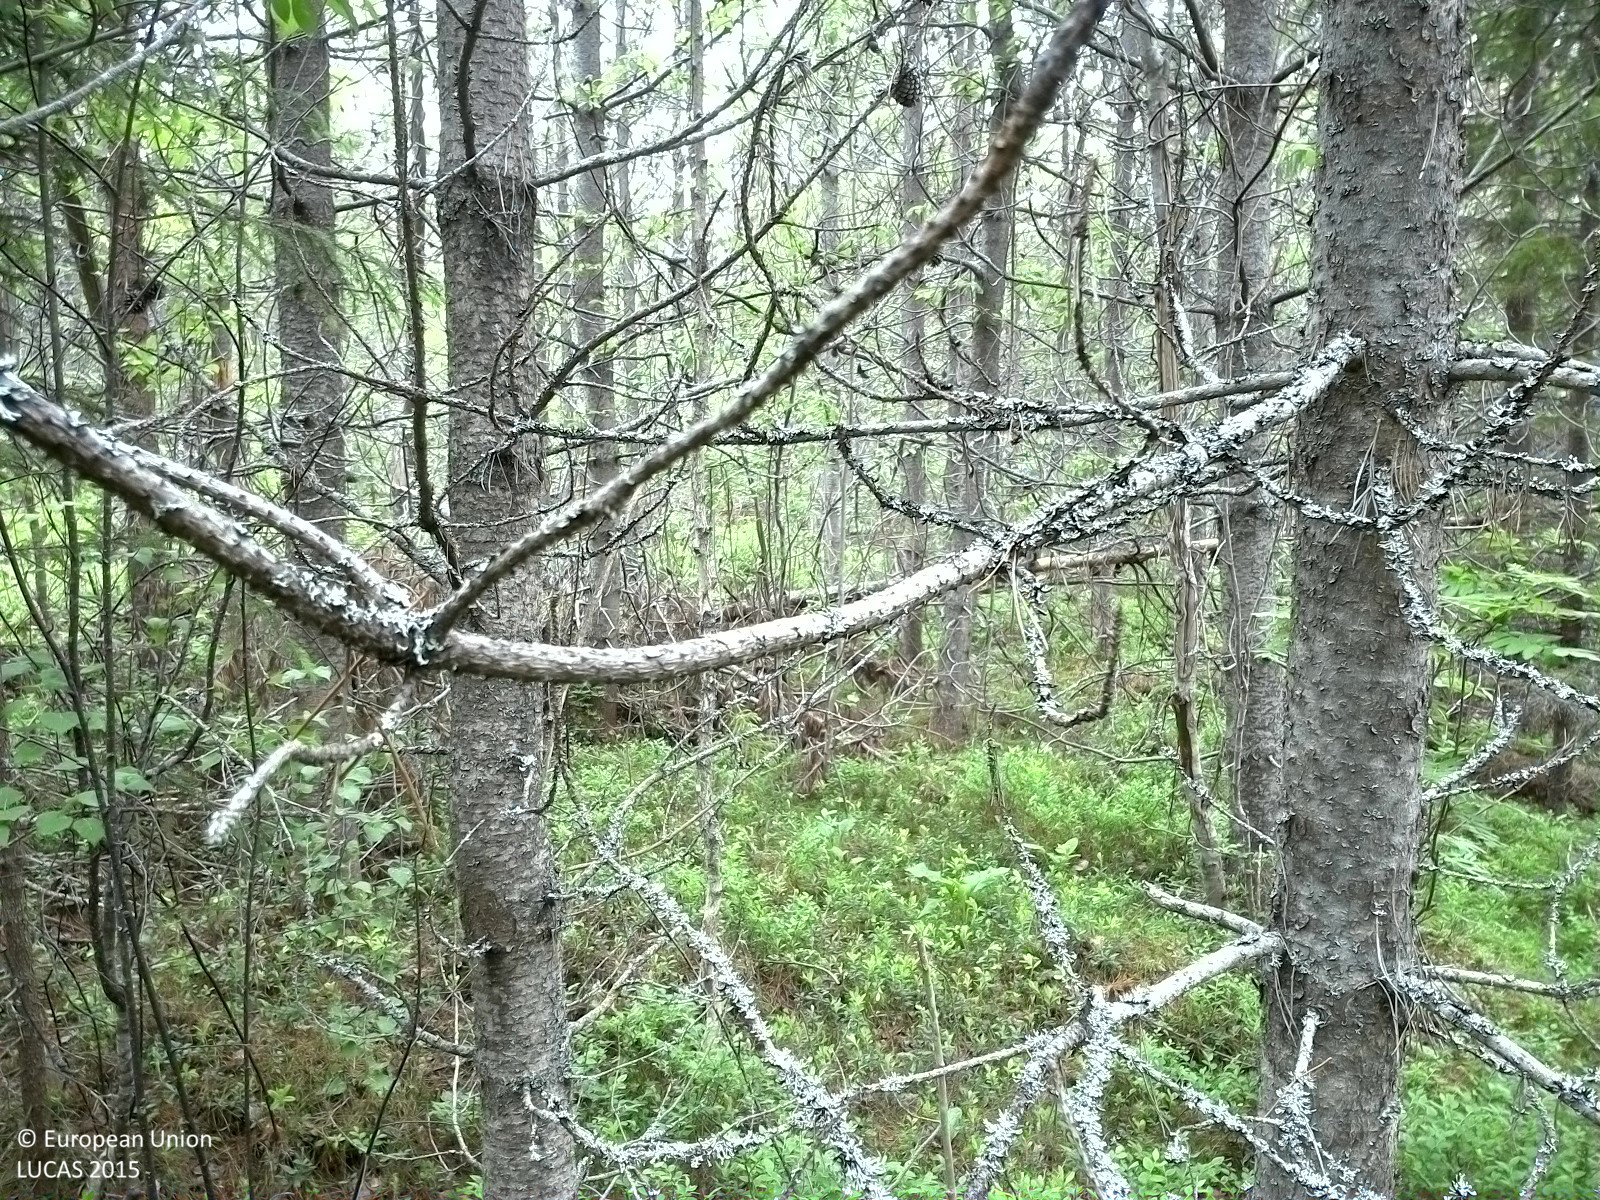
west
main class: Woodland
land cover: Pine dominated coniferous woodland
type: exotic forest
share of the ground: > 75 %
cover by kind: coniferous forest trees 75 %, shrubs 10 %, broadleaved forest trees 5 %, herbaceous plants 5 %, lichens and mosses 5 %
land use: Forestry
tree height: > 5 m
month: July
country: SE
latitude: 62.1339
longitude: 16.3673
